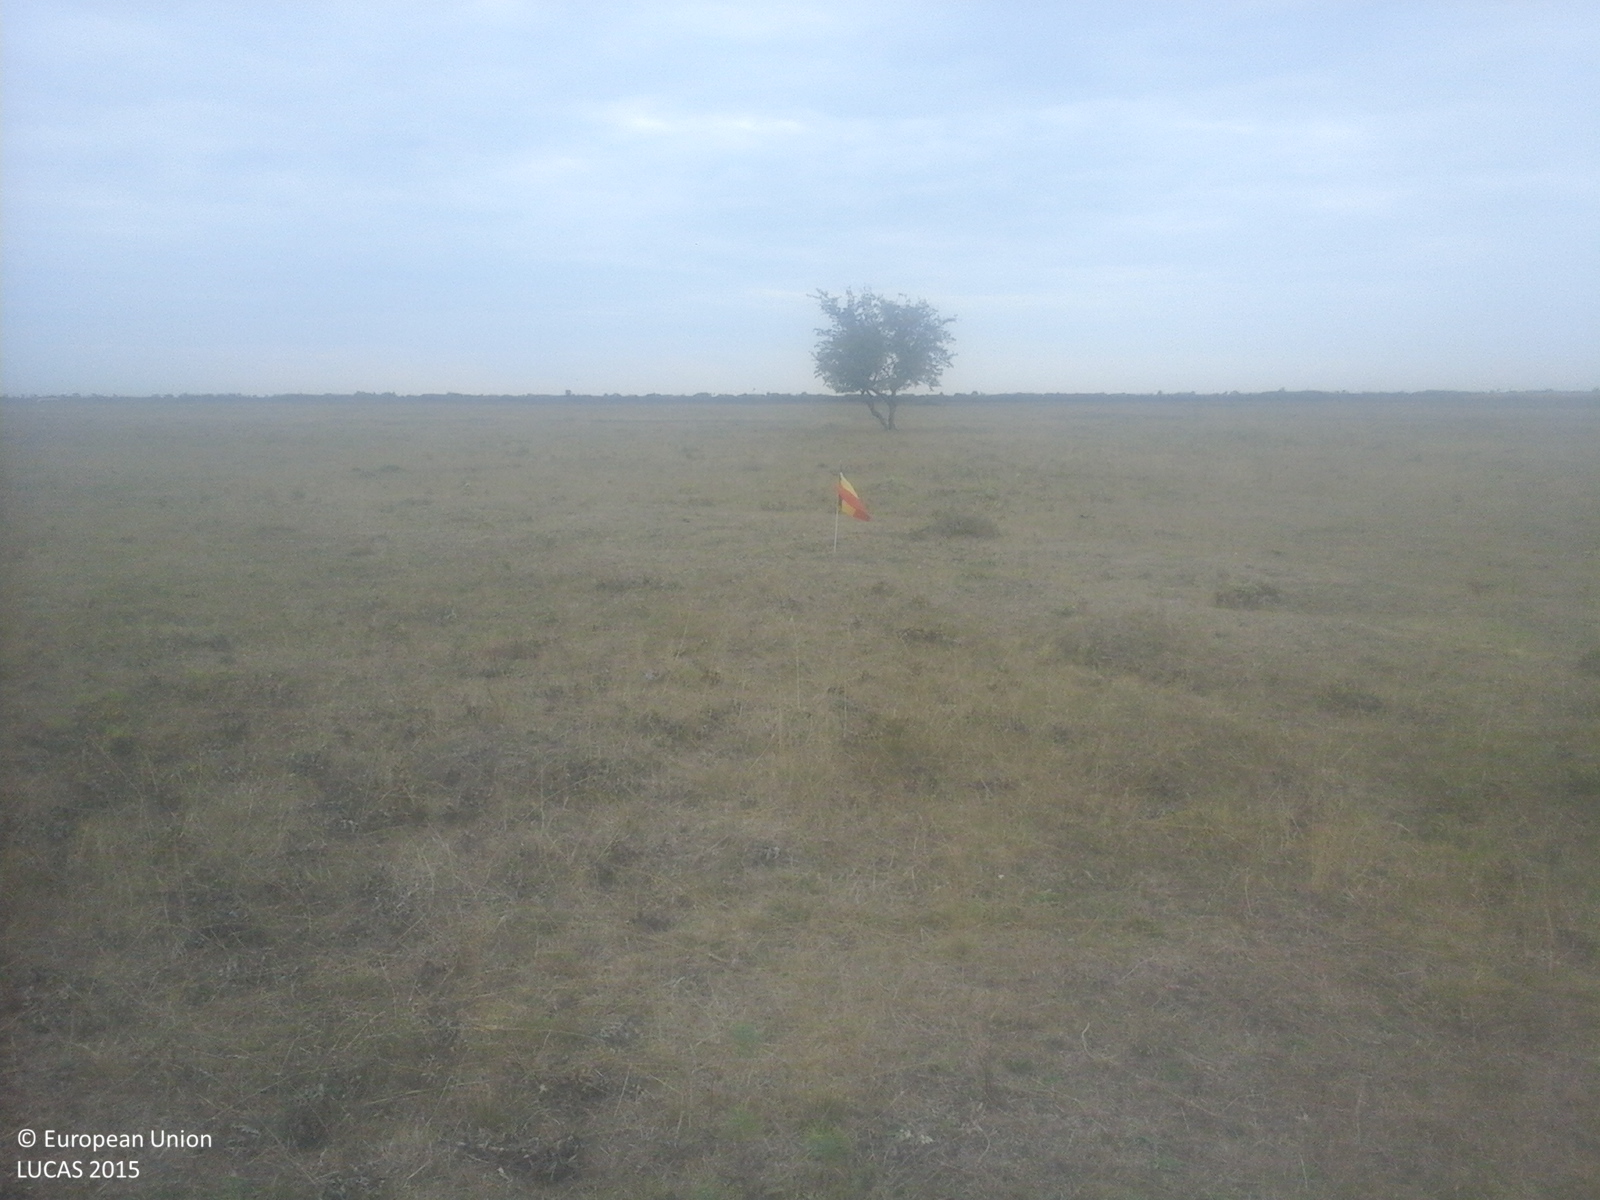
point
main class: Grassland
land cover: Grassland without tree/shrub cover
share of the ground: > 75 %
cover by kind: herbaceous plants 100 %
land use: Agriculture (excluding fallow land and kitchen gardens)
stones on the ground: < 10 %
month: September
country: RO
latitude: 47.7031
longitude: 22.7082
